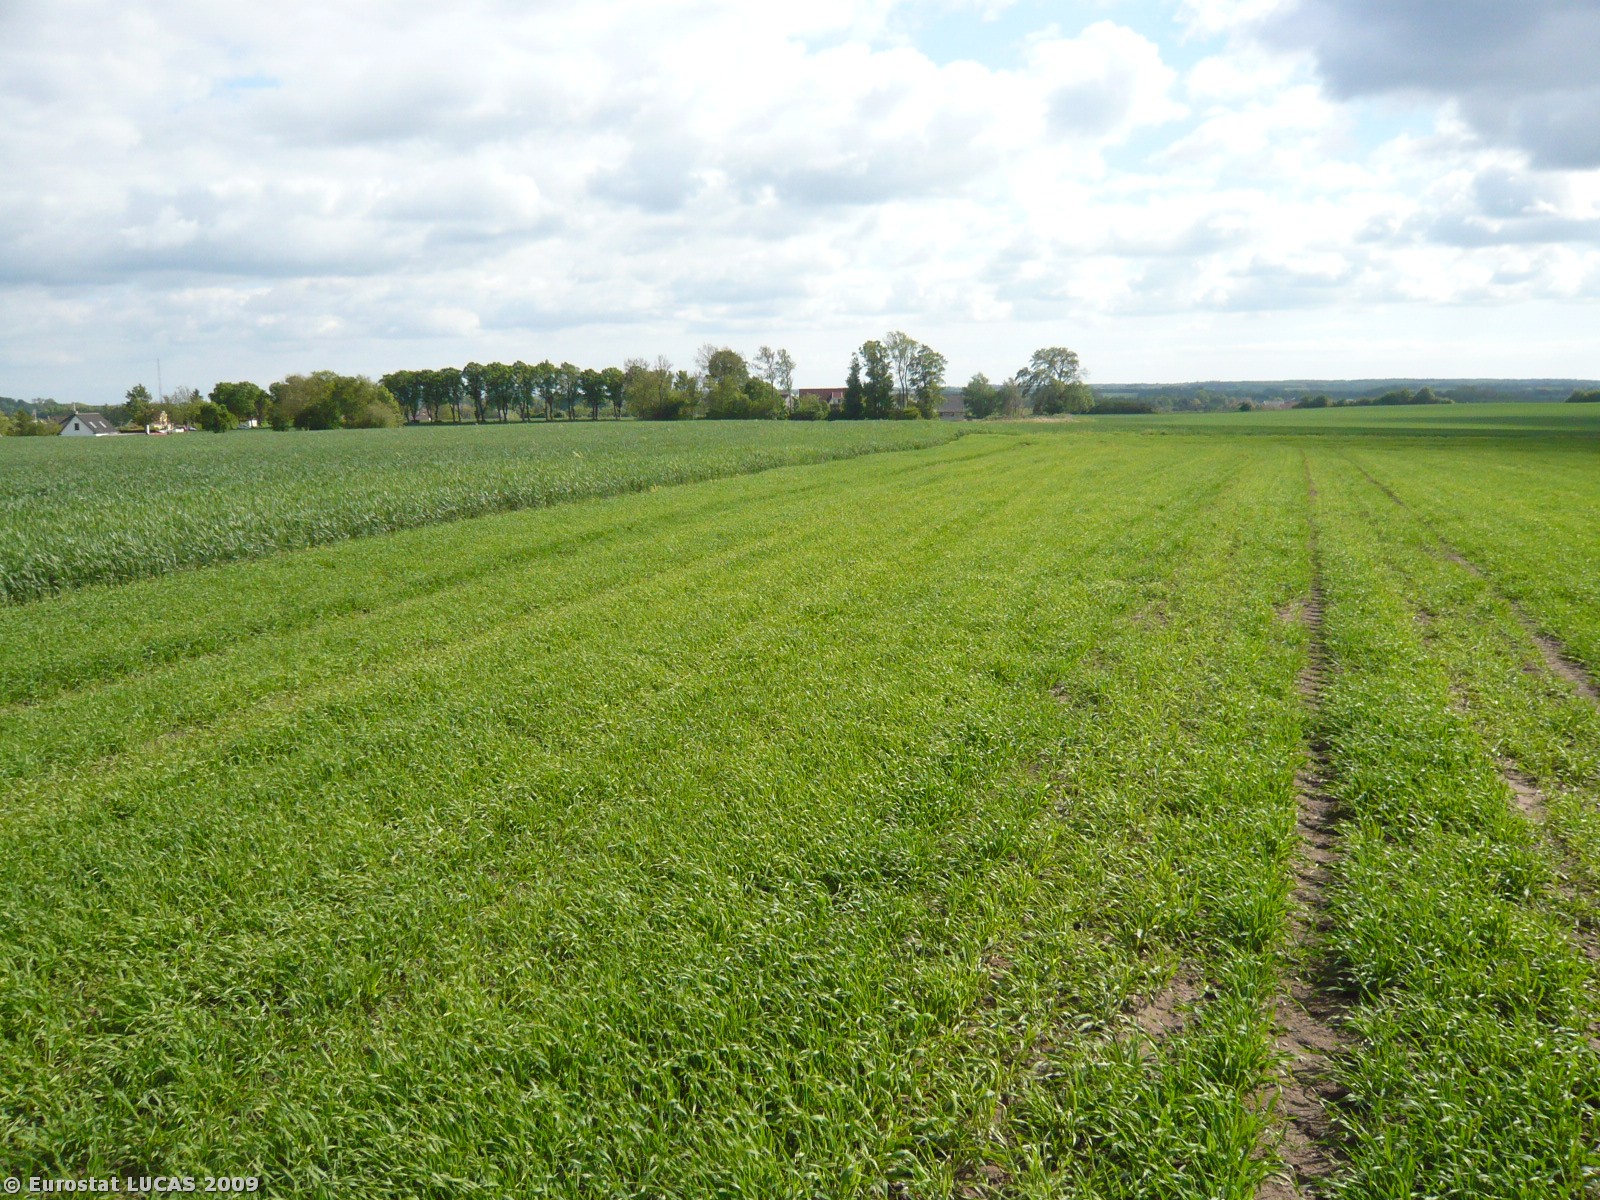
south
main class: Cropland
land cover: Barley
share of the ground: > 75 %
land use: Agriculture (excluding fallow land and kitchen gardens)
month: May
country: DK
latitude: 55.3676
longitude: 11.6868
